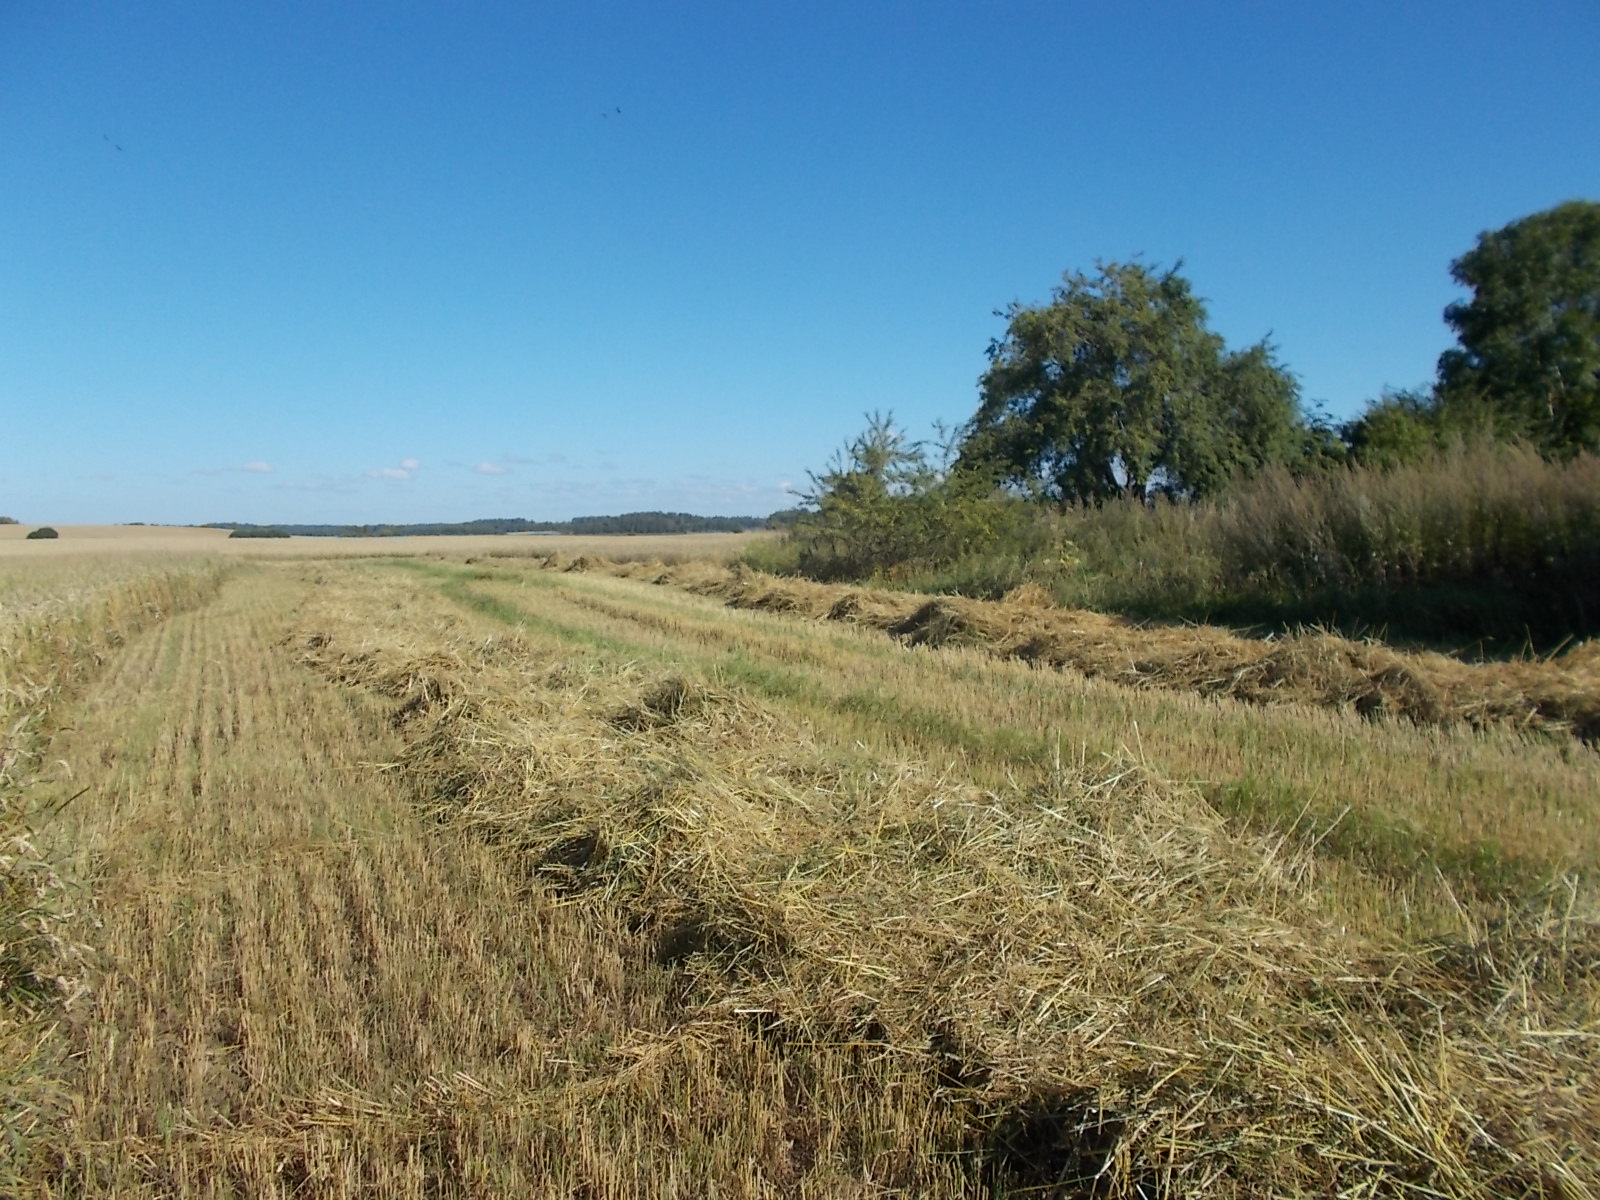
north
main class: Cropland
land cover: Common wheat
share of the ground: > 75 %
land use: Agriculture (excluding fallow land and kitchen gardens)
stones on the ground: < 10 %
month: August
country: LV
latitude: 56.9056
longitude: 22.8535
